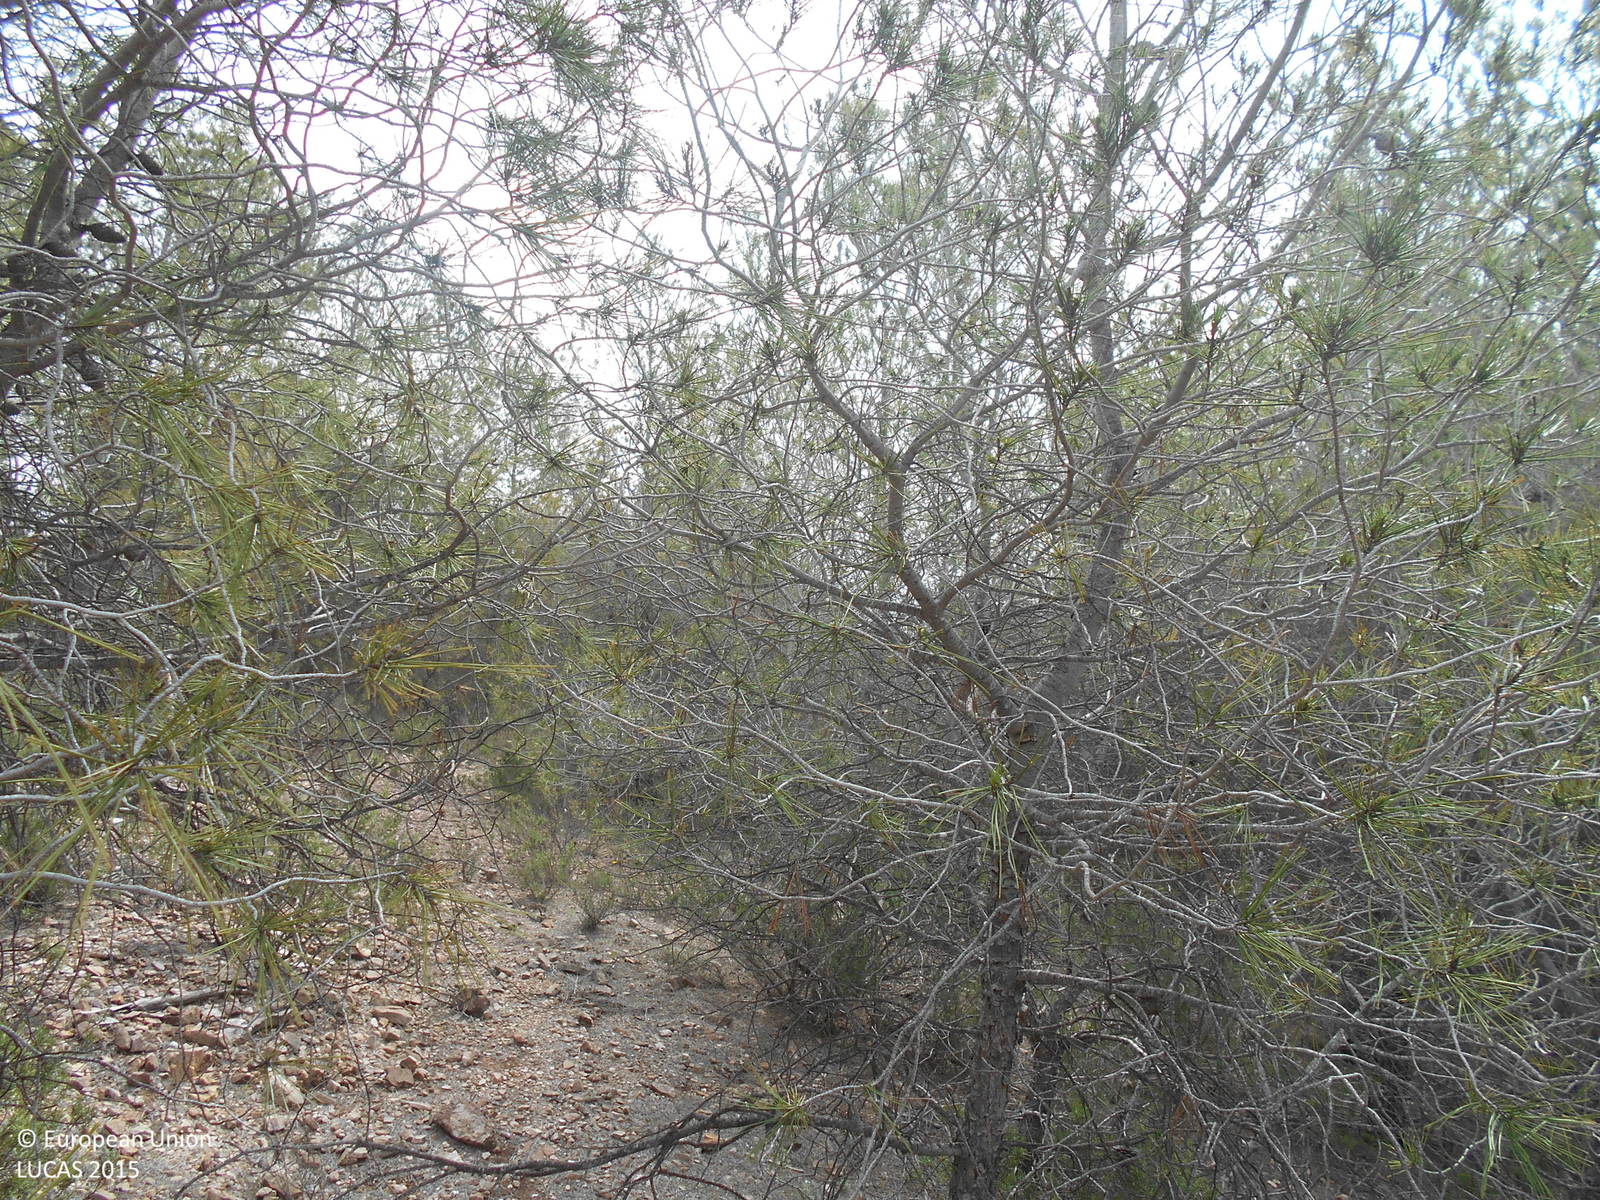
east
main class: Woodland
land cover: Pine dominated coniferous woodland
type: coniferous forest of the mediterranean region
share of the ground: 50 - 75 %
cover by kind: coniferous forest trees 70 %, unconsolidated bare surface 20 %, shrubs 10 %
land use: Semi-natural and natural areas not in use
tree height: > 5 m
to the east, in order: Pine dominated coniferous woodland; Tracks; Pine dominated coniferous woodland; Shrubland without tree cover; Rock outcrops; Pine dominated coniferous woodland
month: April
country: ES
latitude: 37.7910
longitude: -1.5549
